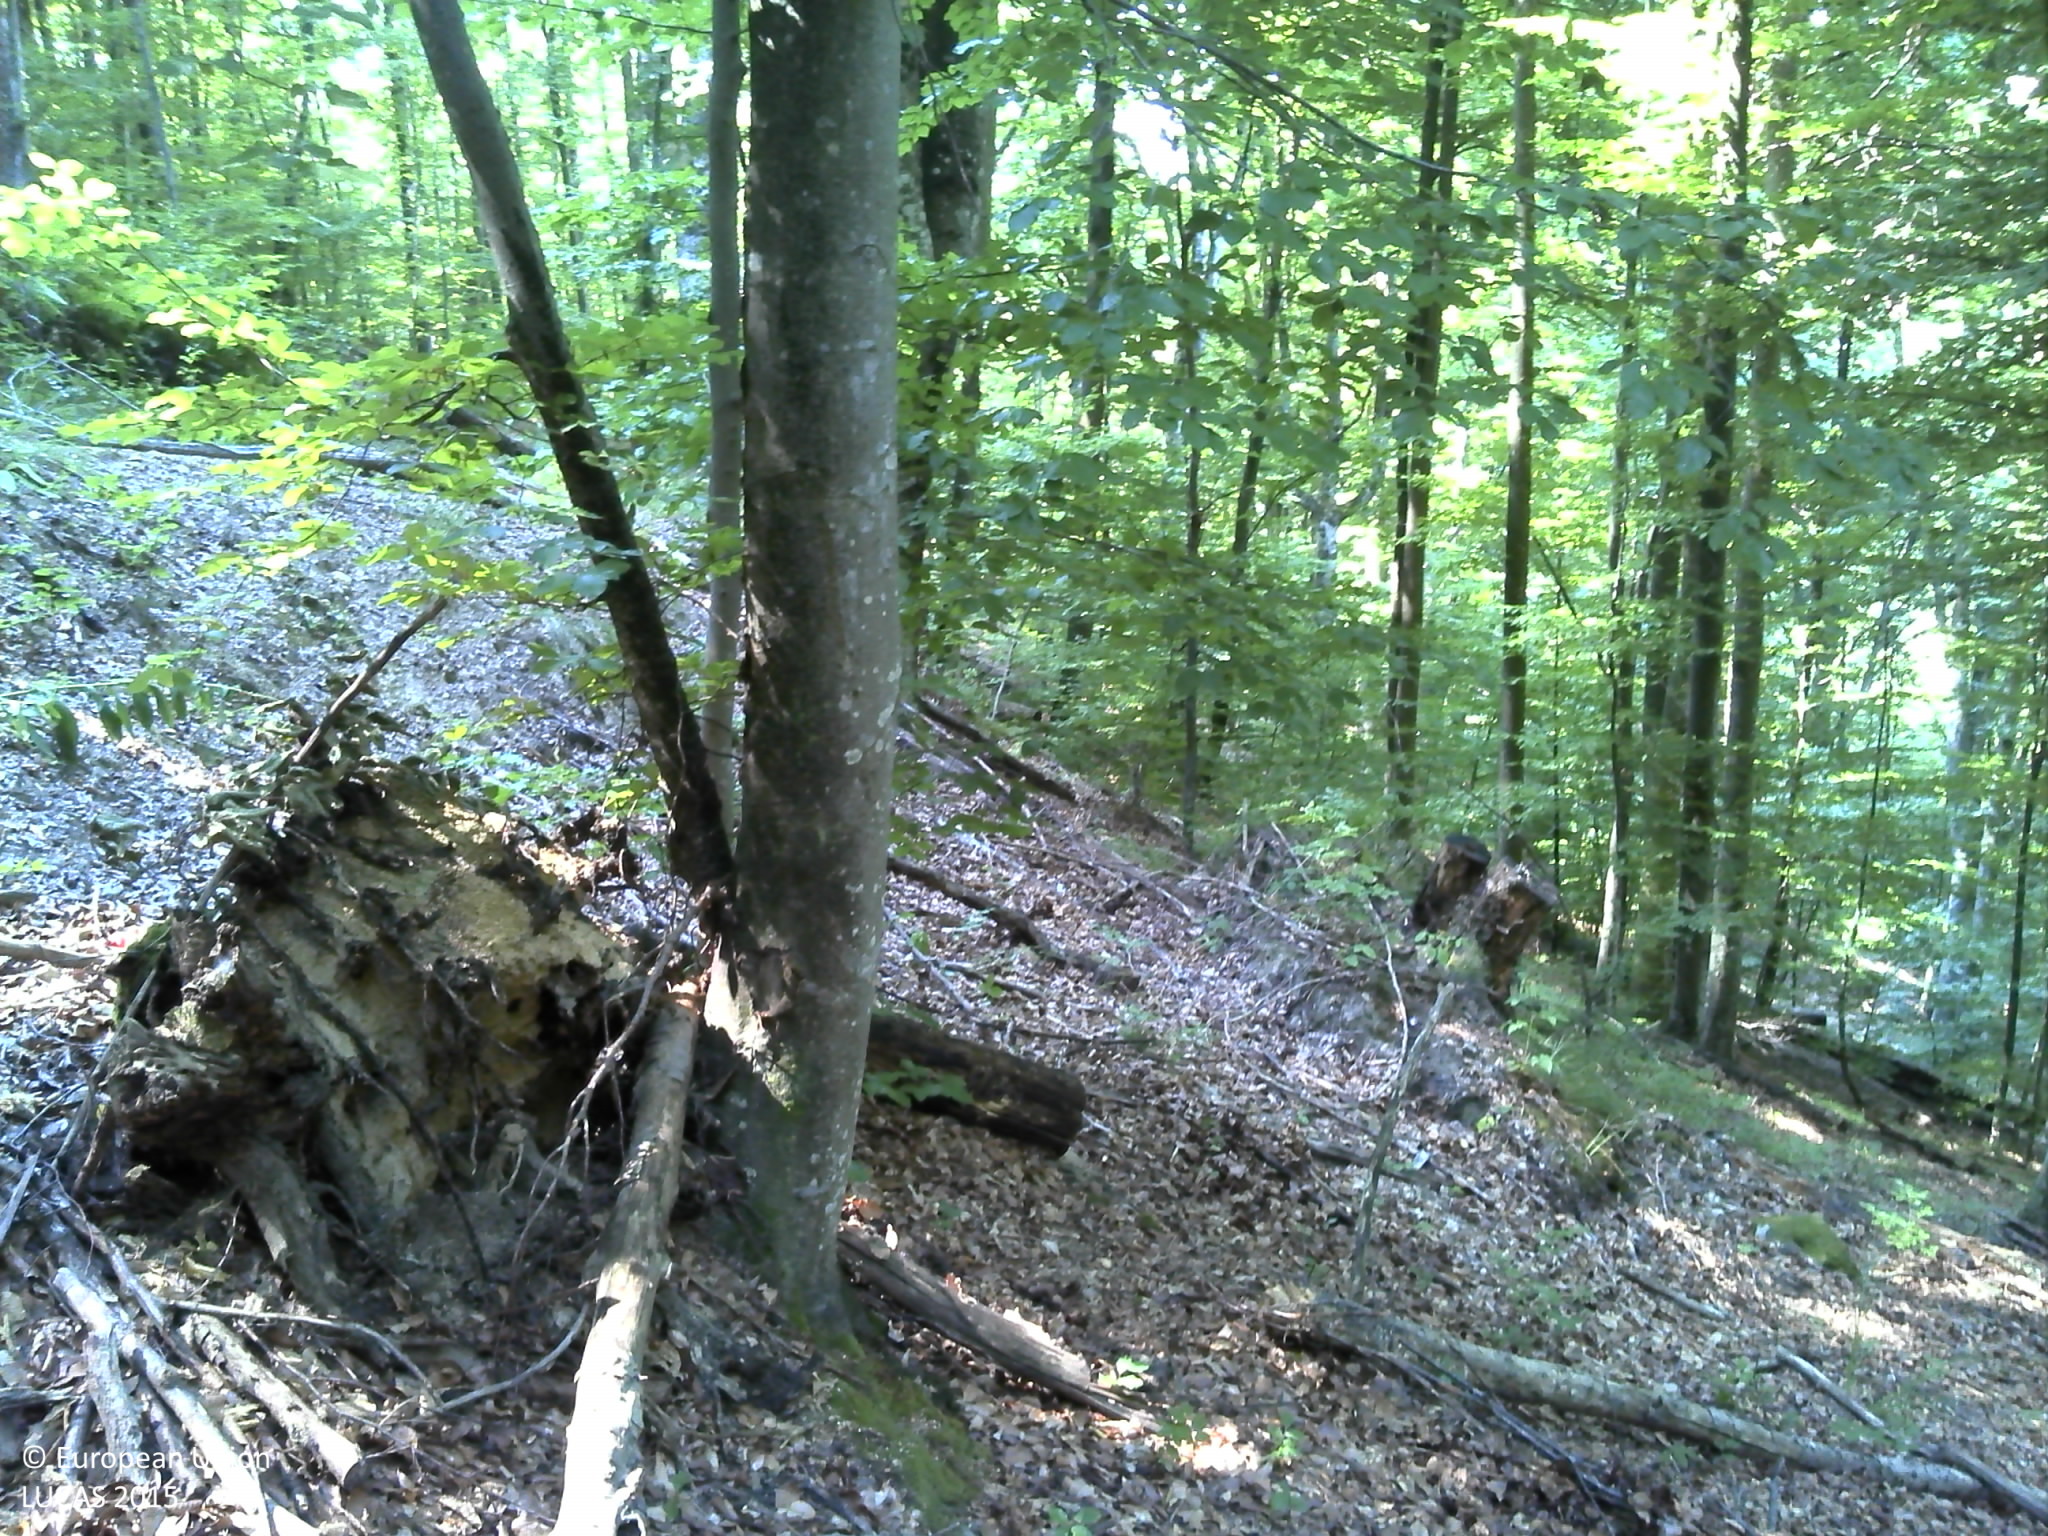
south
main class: Woodland
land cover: Broadleaved woodland
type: beech forest
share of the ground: > 75 %
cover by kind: broadleaved forest trees 100 %
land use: Forestry
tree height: > 5 m
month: August
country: HR
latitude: 45.5544
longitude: 17.3669
